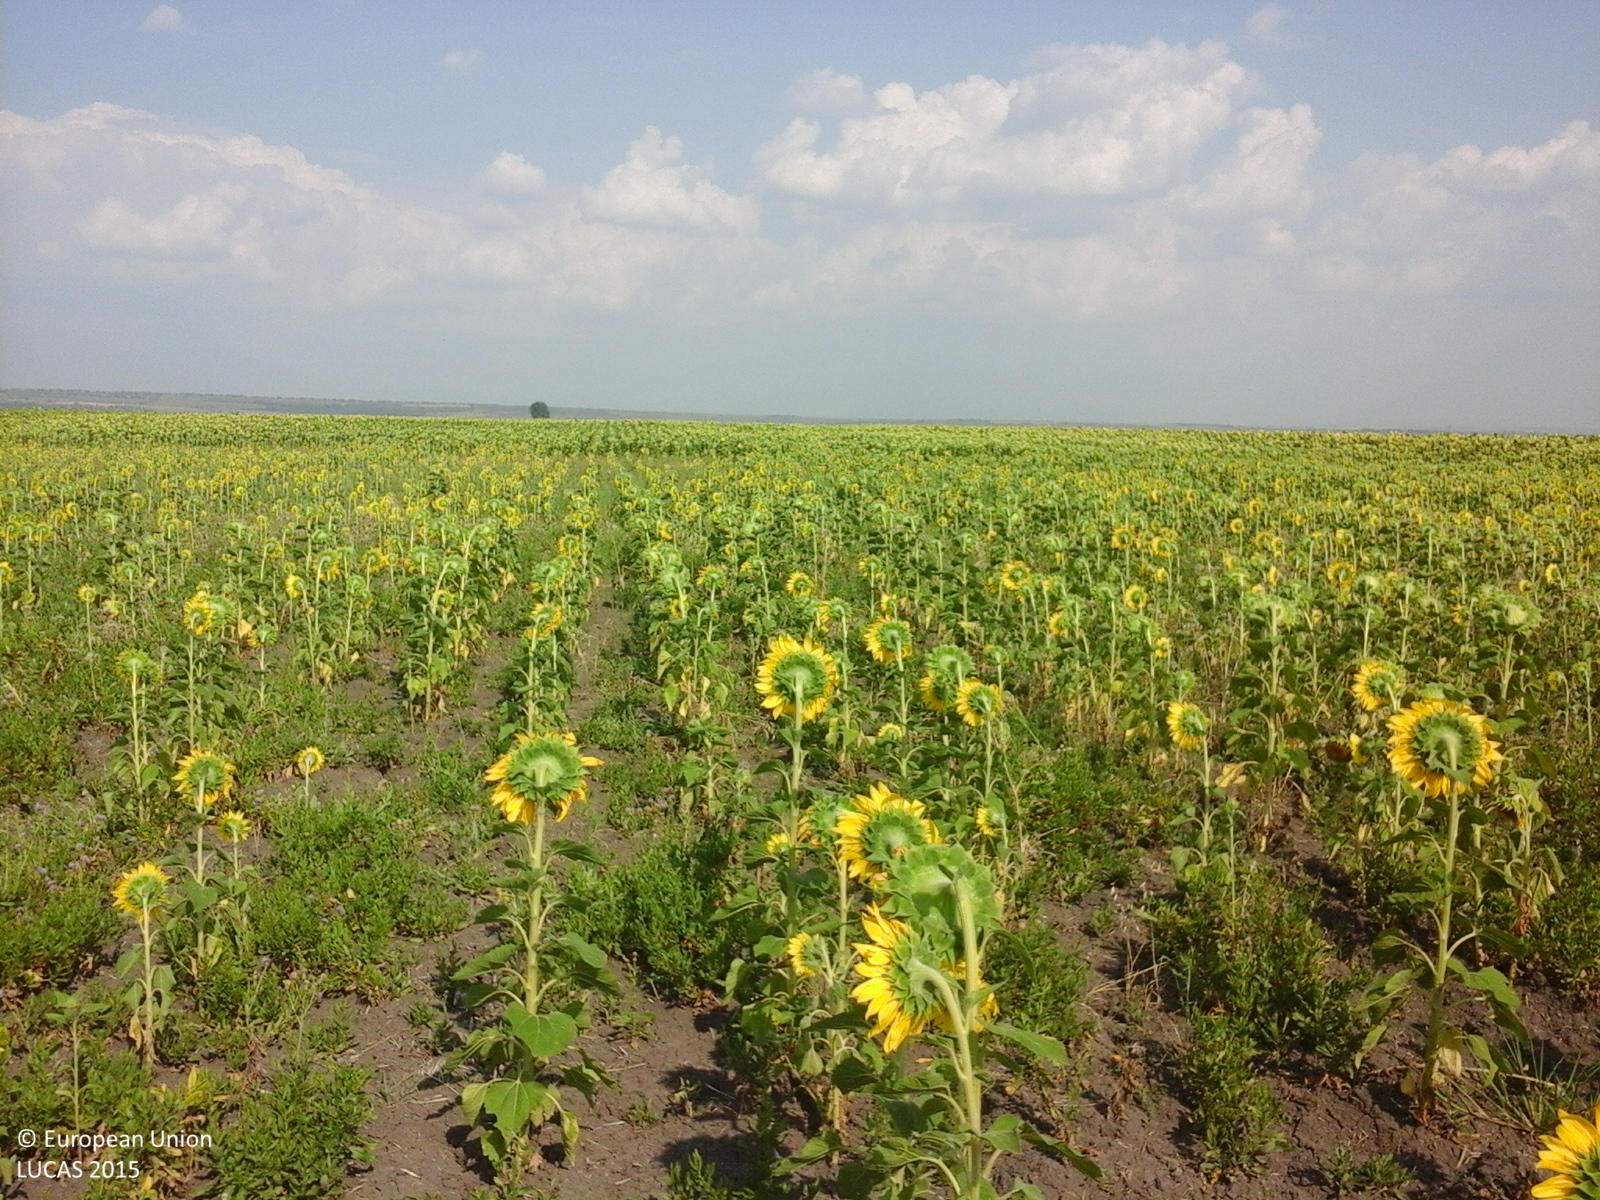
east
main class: Cropland
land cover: Sunflower
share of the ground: > 75 %
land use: Agriculture (excluding fallow land and kitchen gardens)
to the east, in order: Sunflower
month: July
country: RO
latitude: 46.6575
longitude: 28.1805
